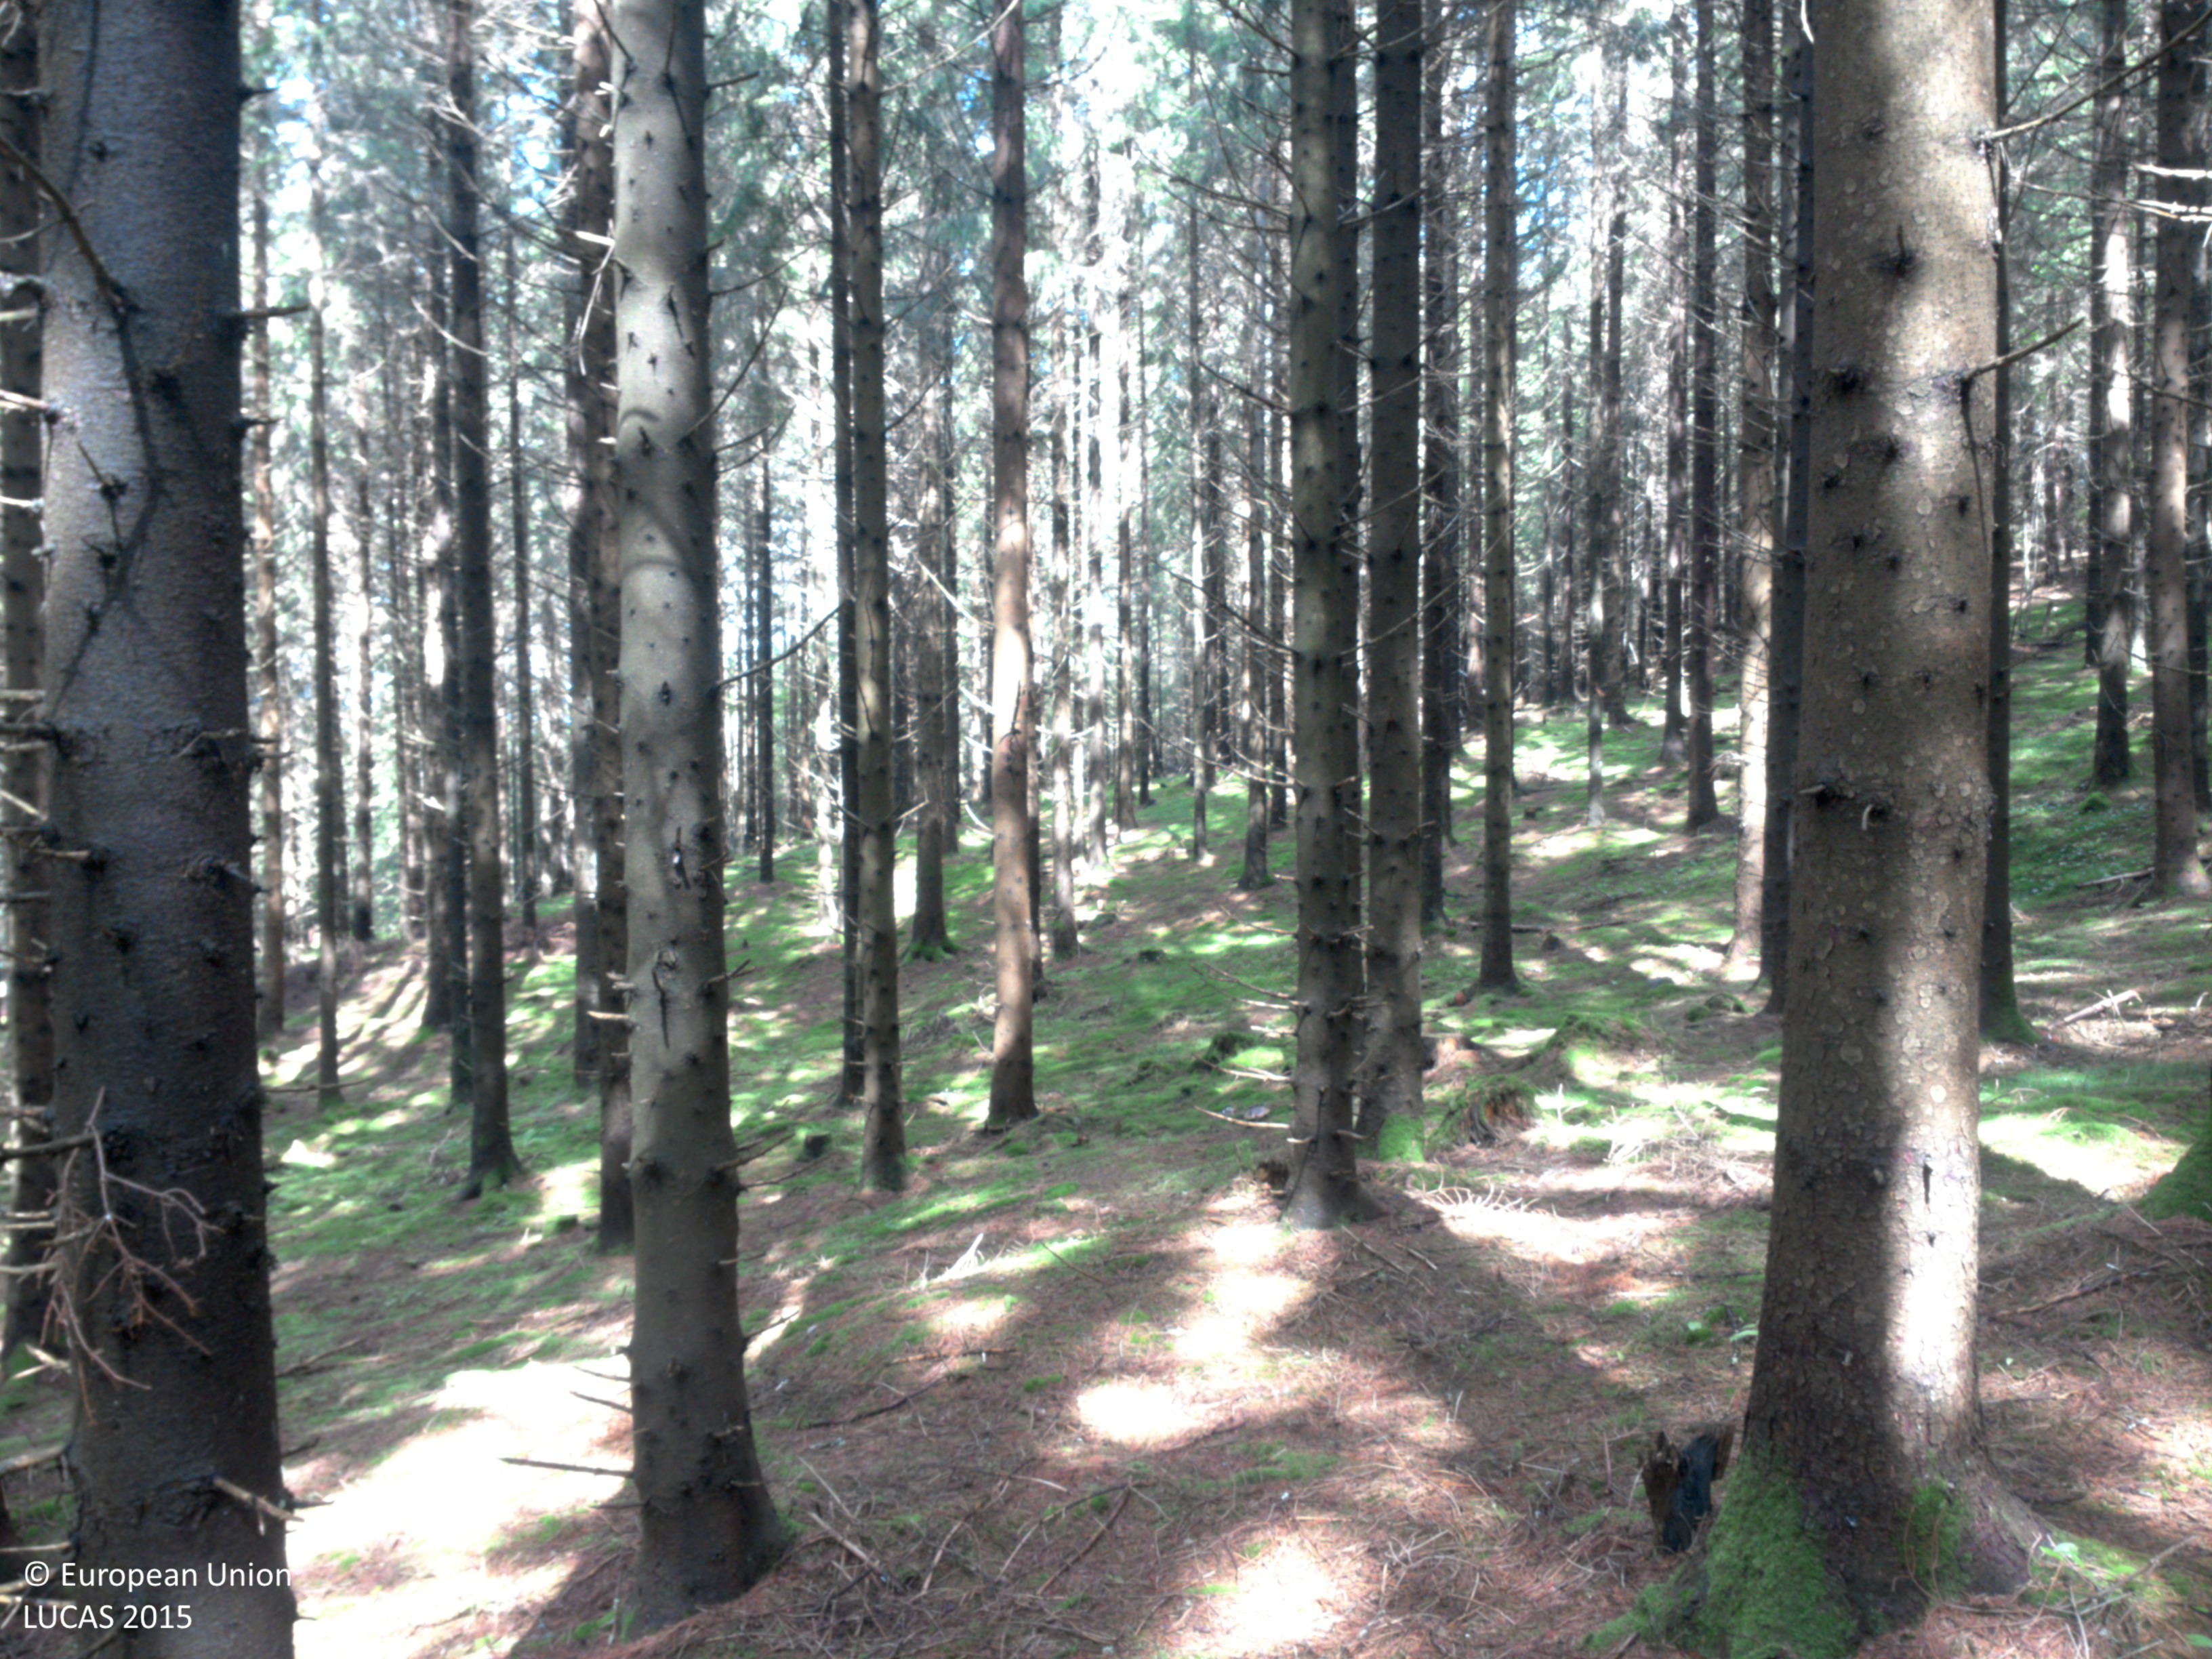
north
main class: Woodland
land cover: Spruce dominated coniferous woodland
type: boreal forest
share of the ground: 50 - 75 %
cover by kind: coniferous forest trees 75 %, lichens and mosses 25 %
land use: Forestry
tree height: > 5 m
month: July
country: SE
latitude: 58.0969
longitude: 11.9812
